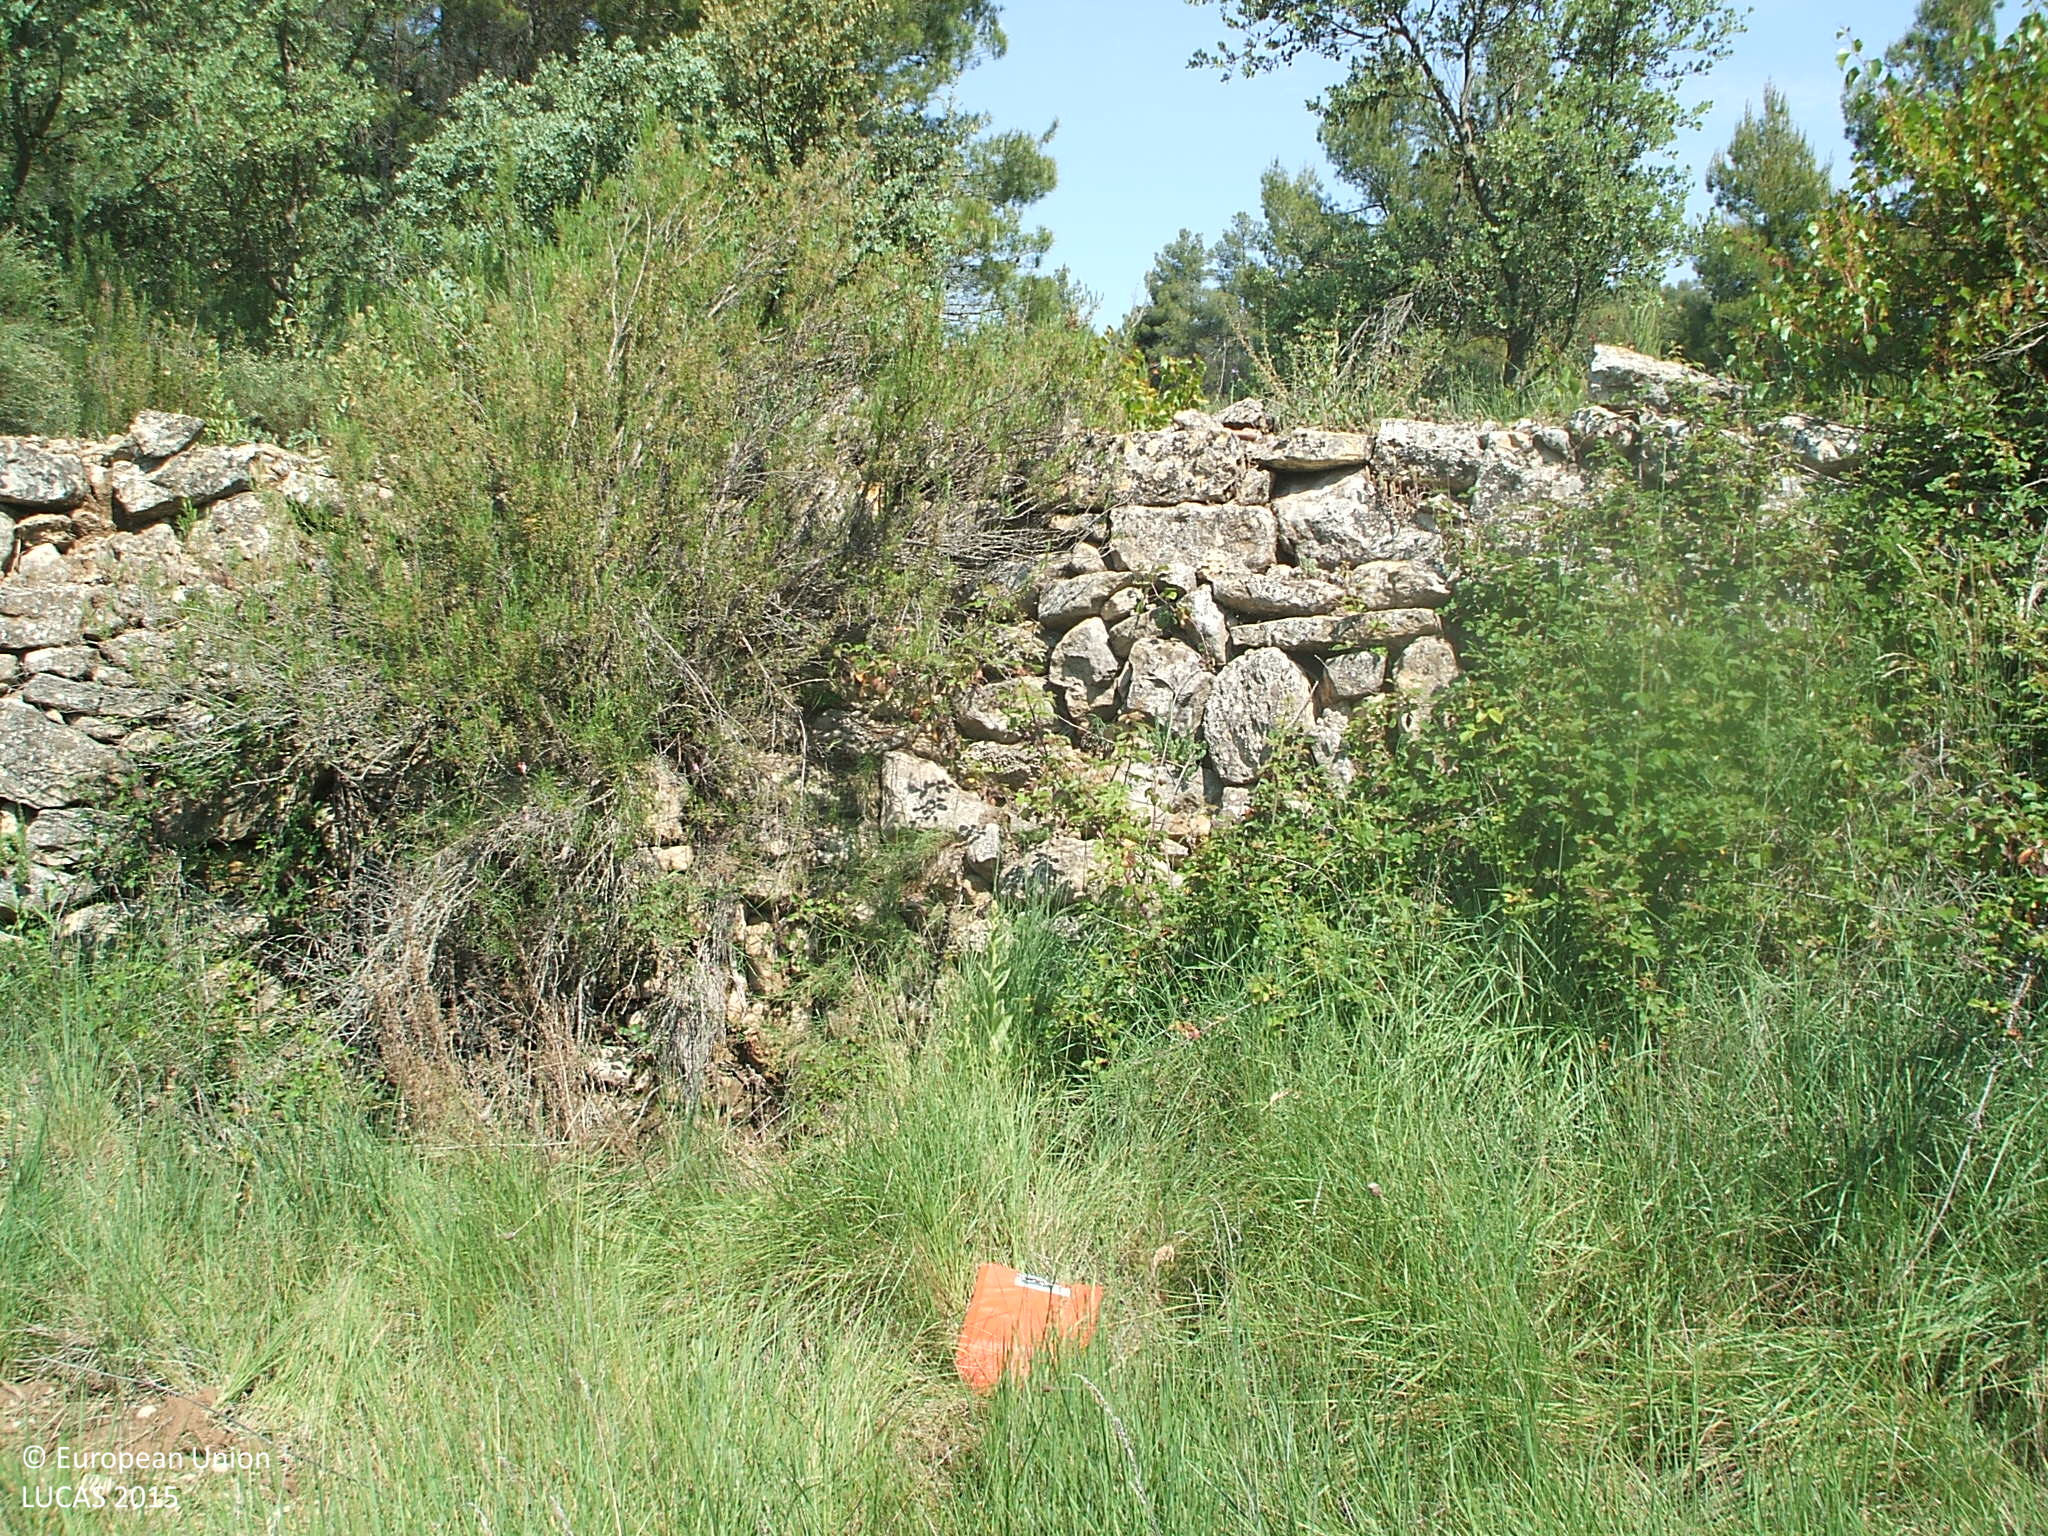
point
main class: Grassland
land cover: Grassland with sparse tree/shrub cover
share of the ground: > 75 %
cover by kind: herbaceous plants 95 %, coniferous forest trees 5 %
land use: Semi-natural and natural areas not in use
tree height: > 5 m
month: June
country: ES
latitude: 40.9009
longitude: -0.0164
